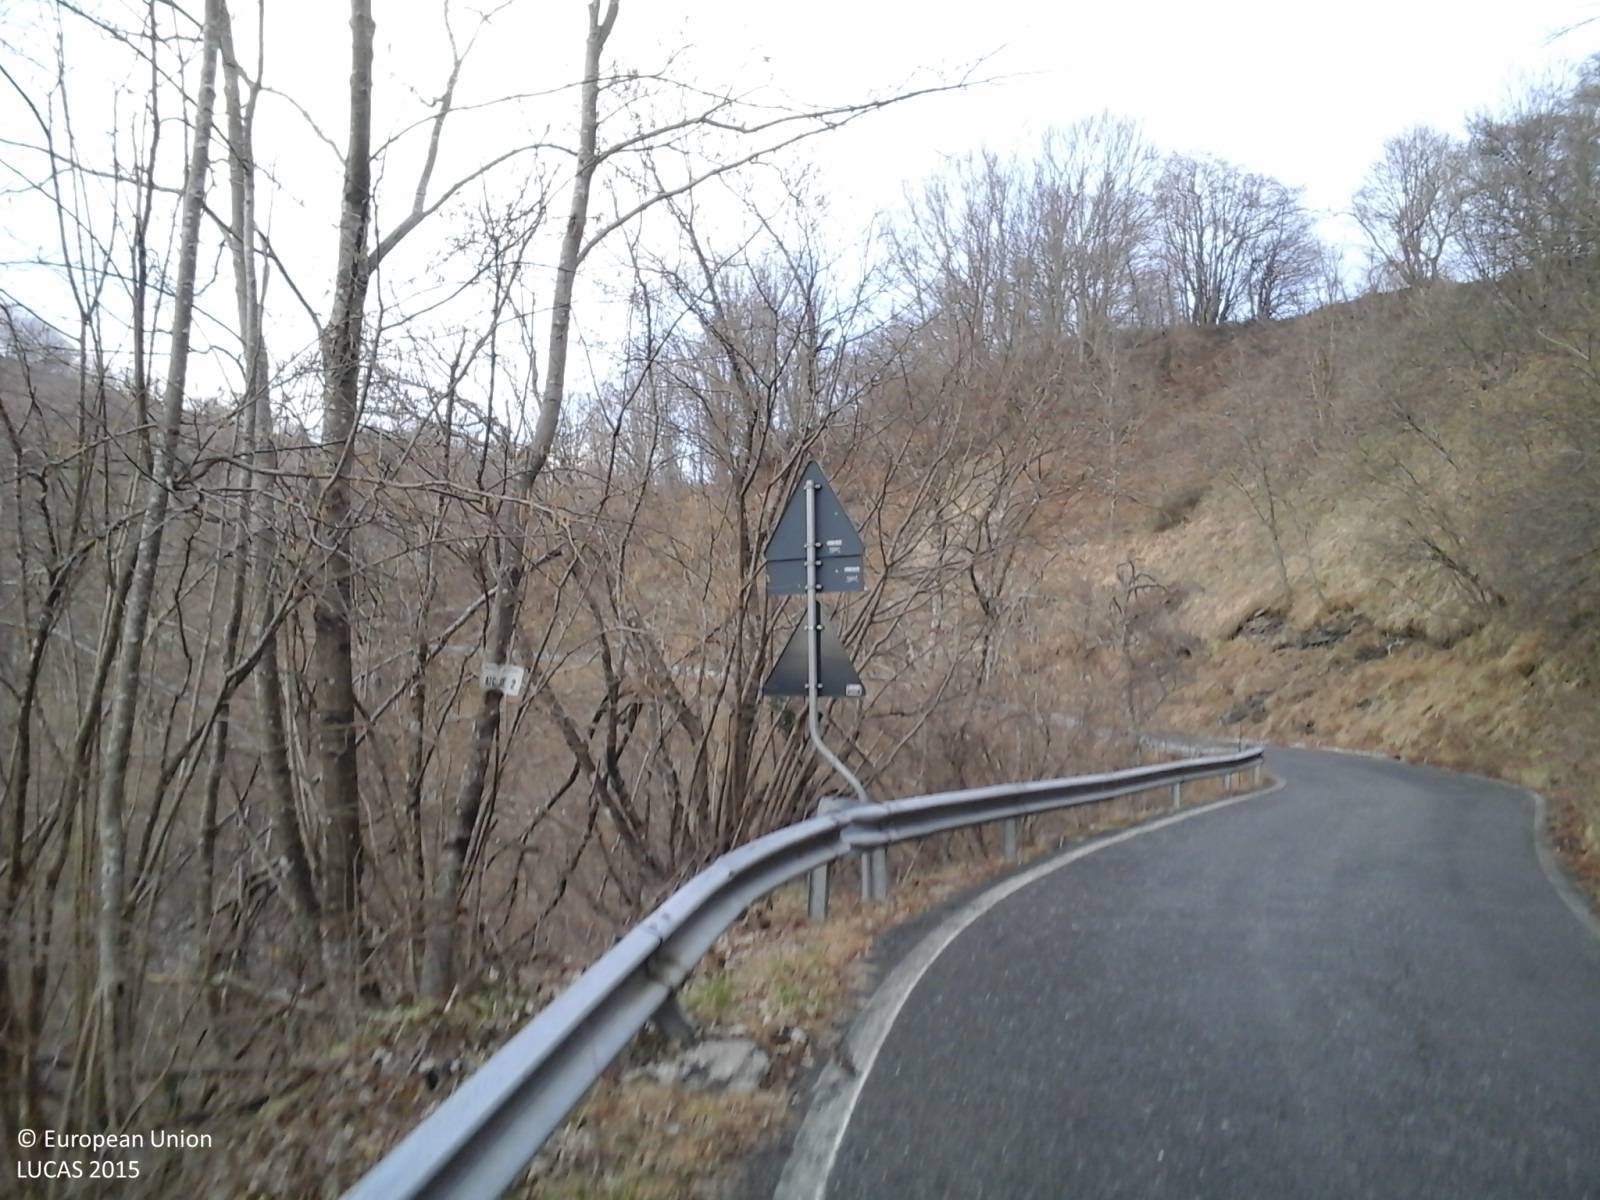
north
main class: Woodland
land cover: Broadleaved woodland
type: mesophytic deciduous forest
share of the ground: > 75 %
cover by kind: broadleaved forest trees 100 %
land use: Forestry
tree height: > 5 m
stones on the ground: 10 - 25 %
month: January
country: IT
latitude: 44.4916
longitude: 9.1844
